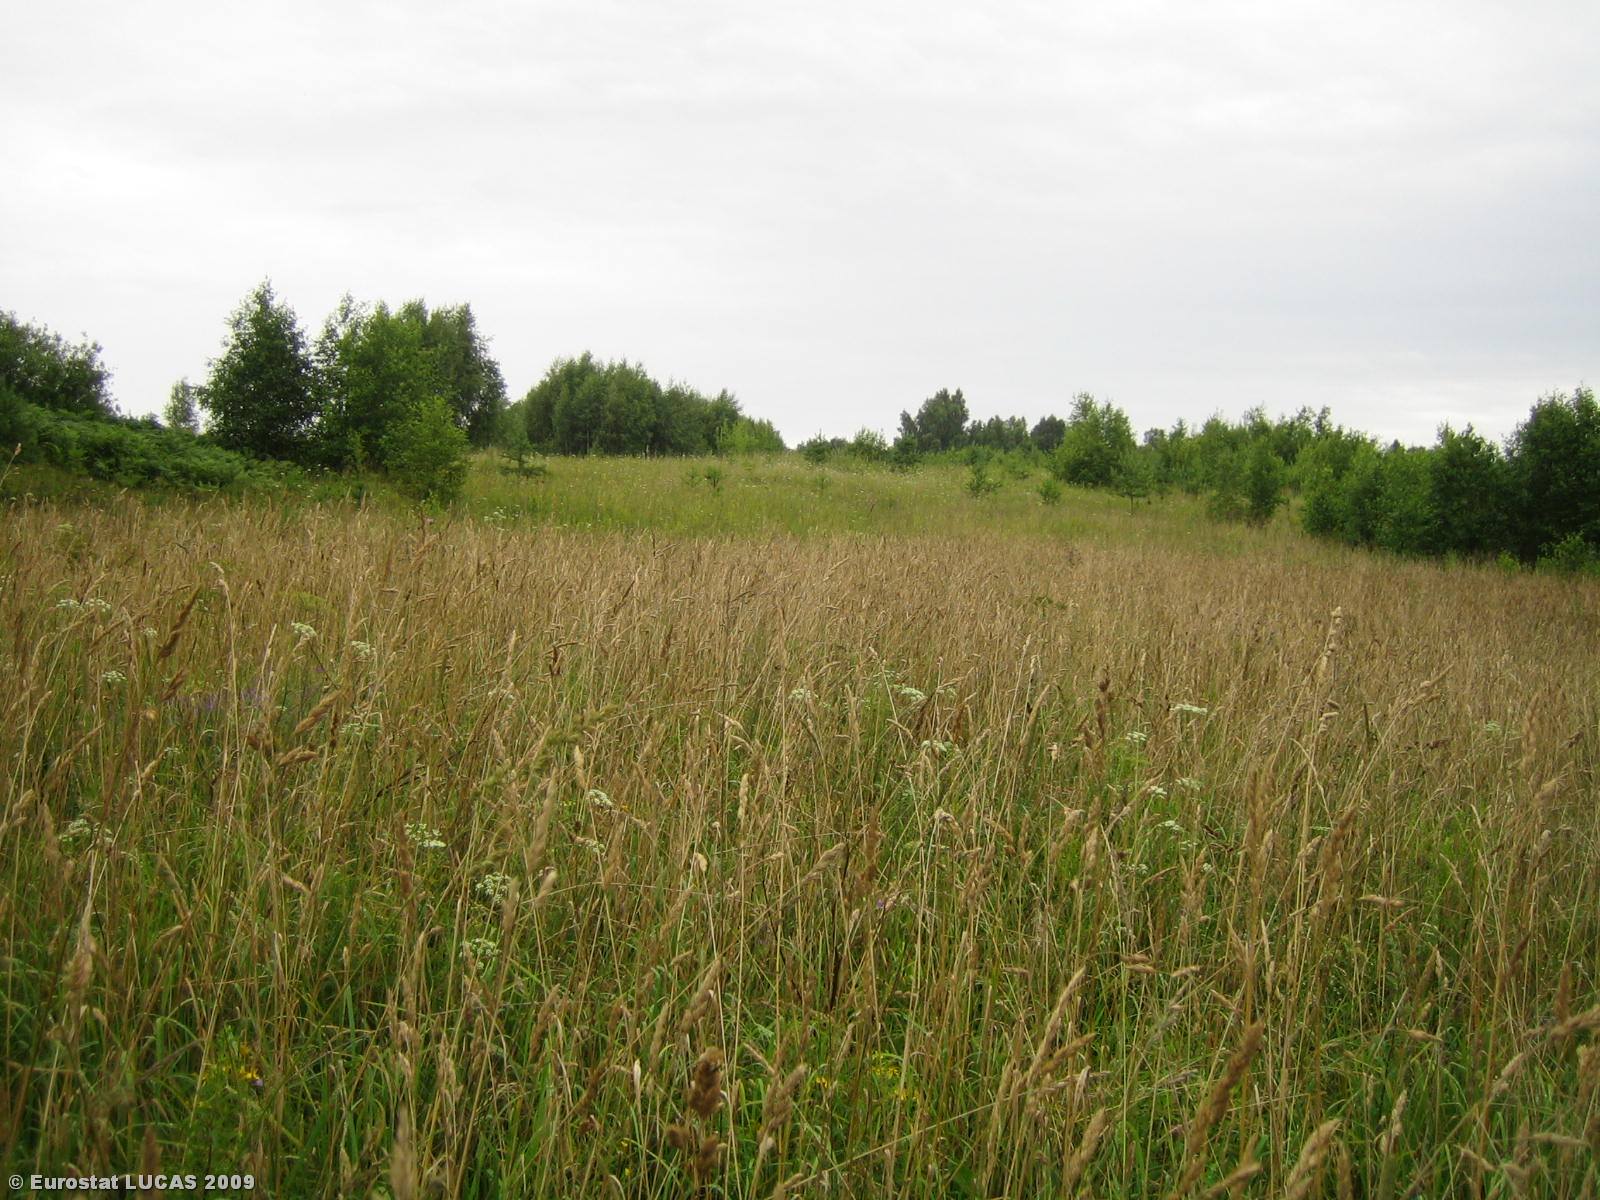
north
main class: Grassland
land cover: Spontaneously vegetated surfaces
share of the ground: > 75 %
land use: Unused
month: July
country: LT
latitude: 55.4019
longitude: 25.6517
